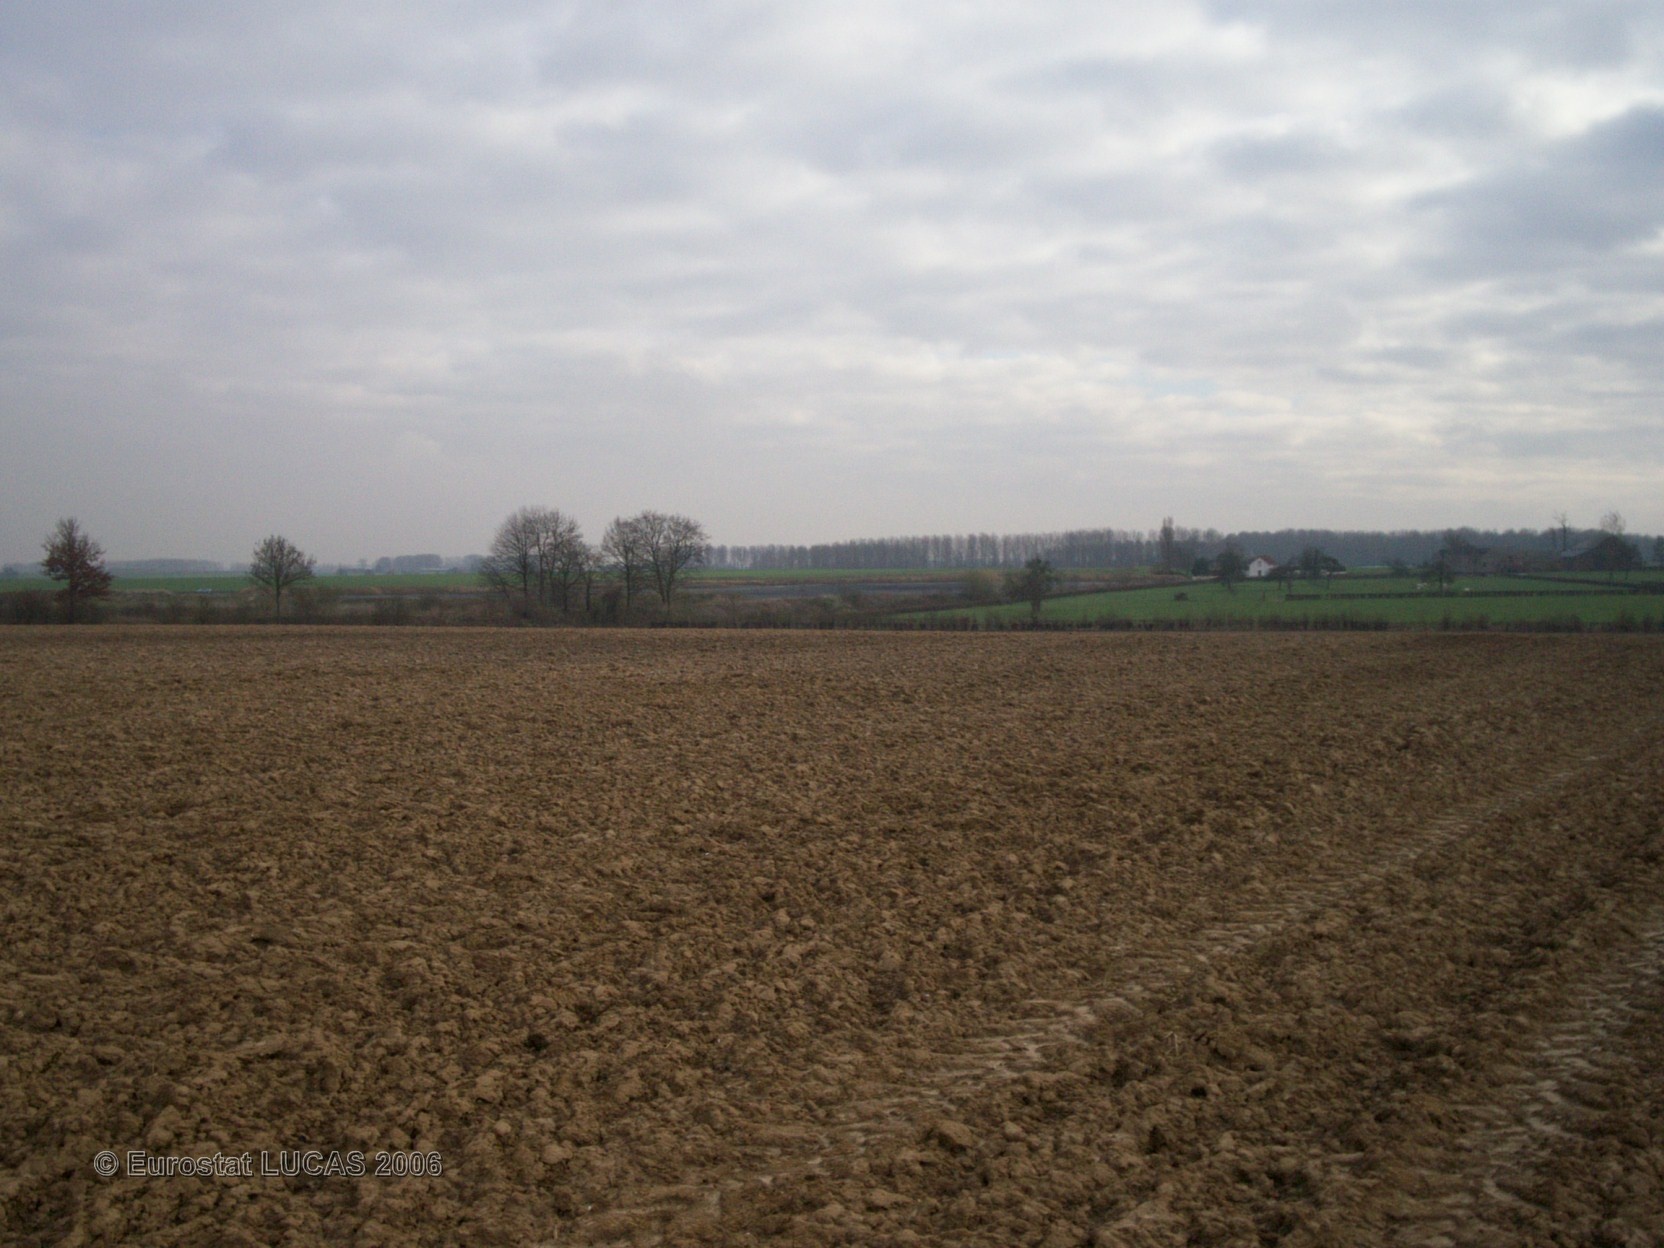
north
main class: Cropland
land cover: Maize
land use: Agriculture (excluding fallow land and kitchen gardens)
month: April
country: FR
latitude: 50.2981
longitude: 3.6899
